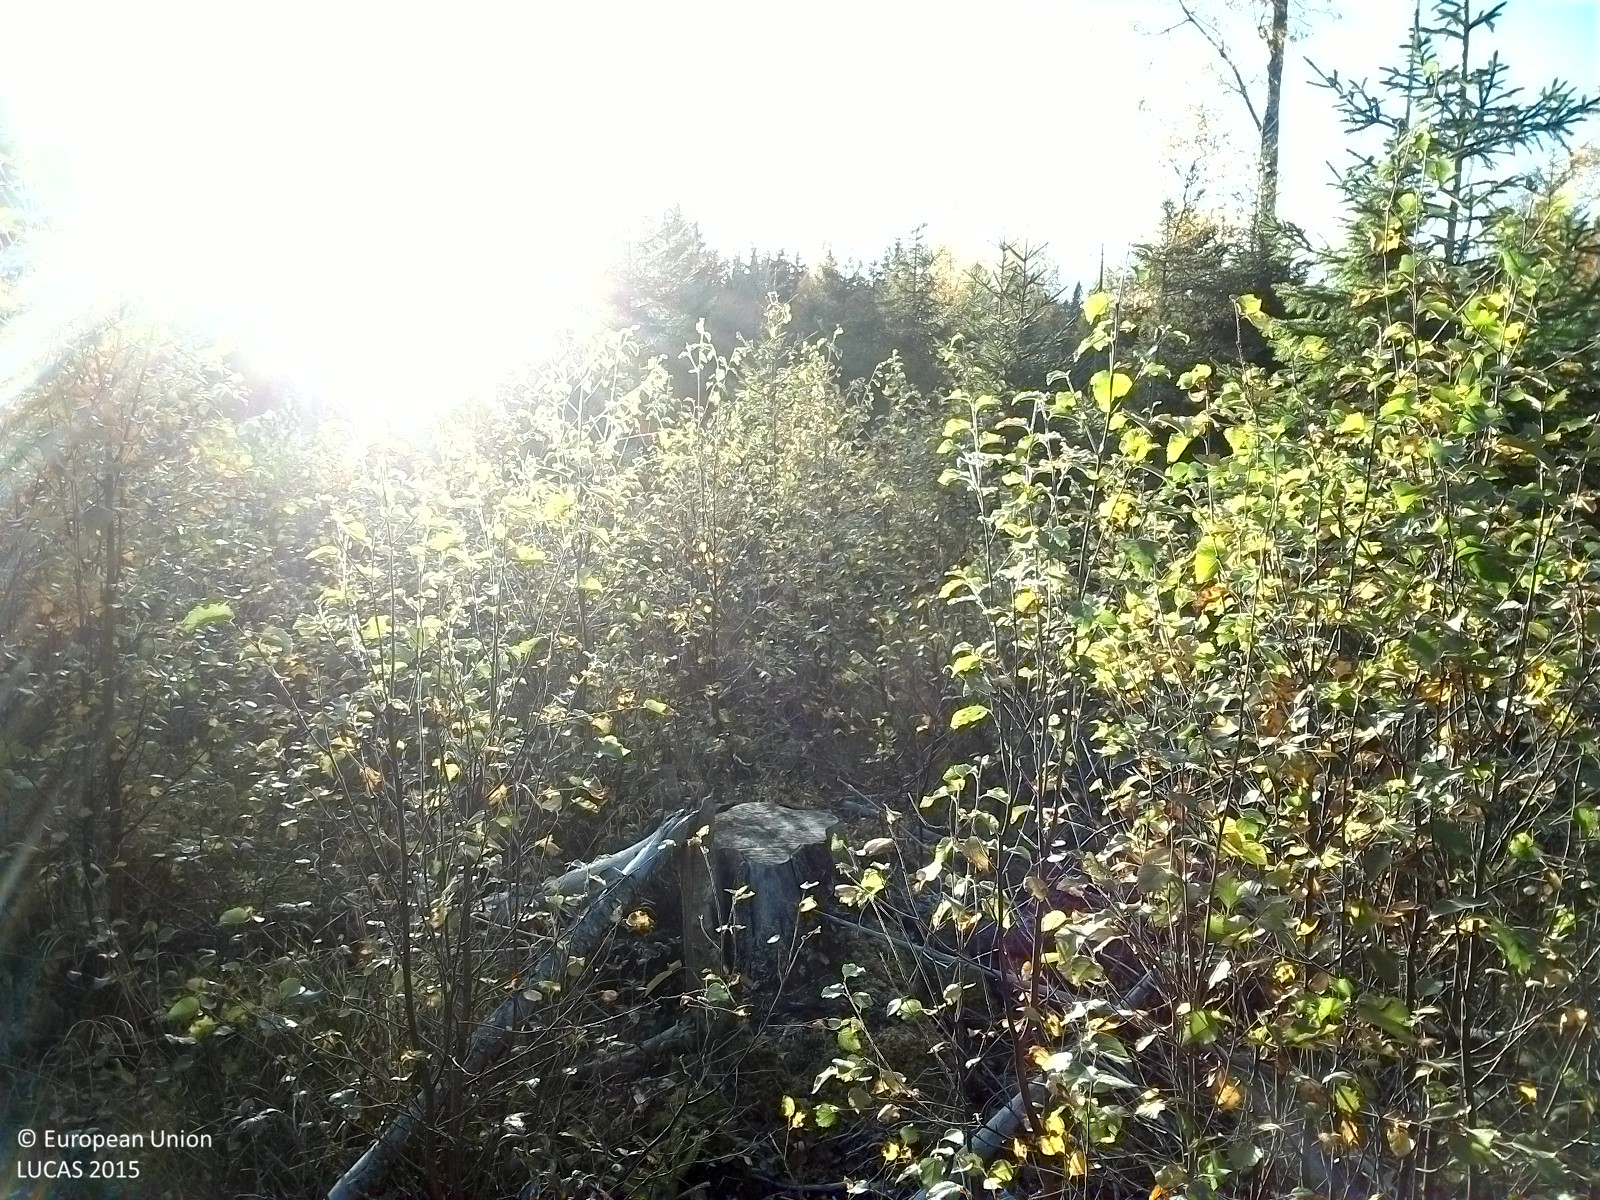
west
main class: Woodland
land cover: Spruce dominated mixed woodland
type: boreal forest
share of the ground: > 75 %
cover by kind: broadleaved forest trees 60 %, coniferous forest trees 20 %, shrubs 20 %
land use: Forestry
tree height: < 5 m
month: September
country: SE
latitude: 62.0958
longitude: 16.8194
